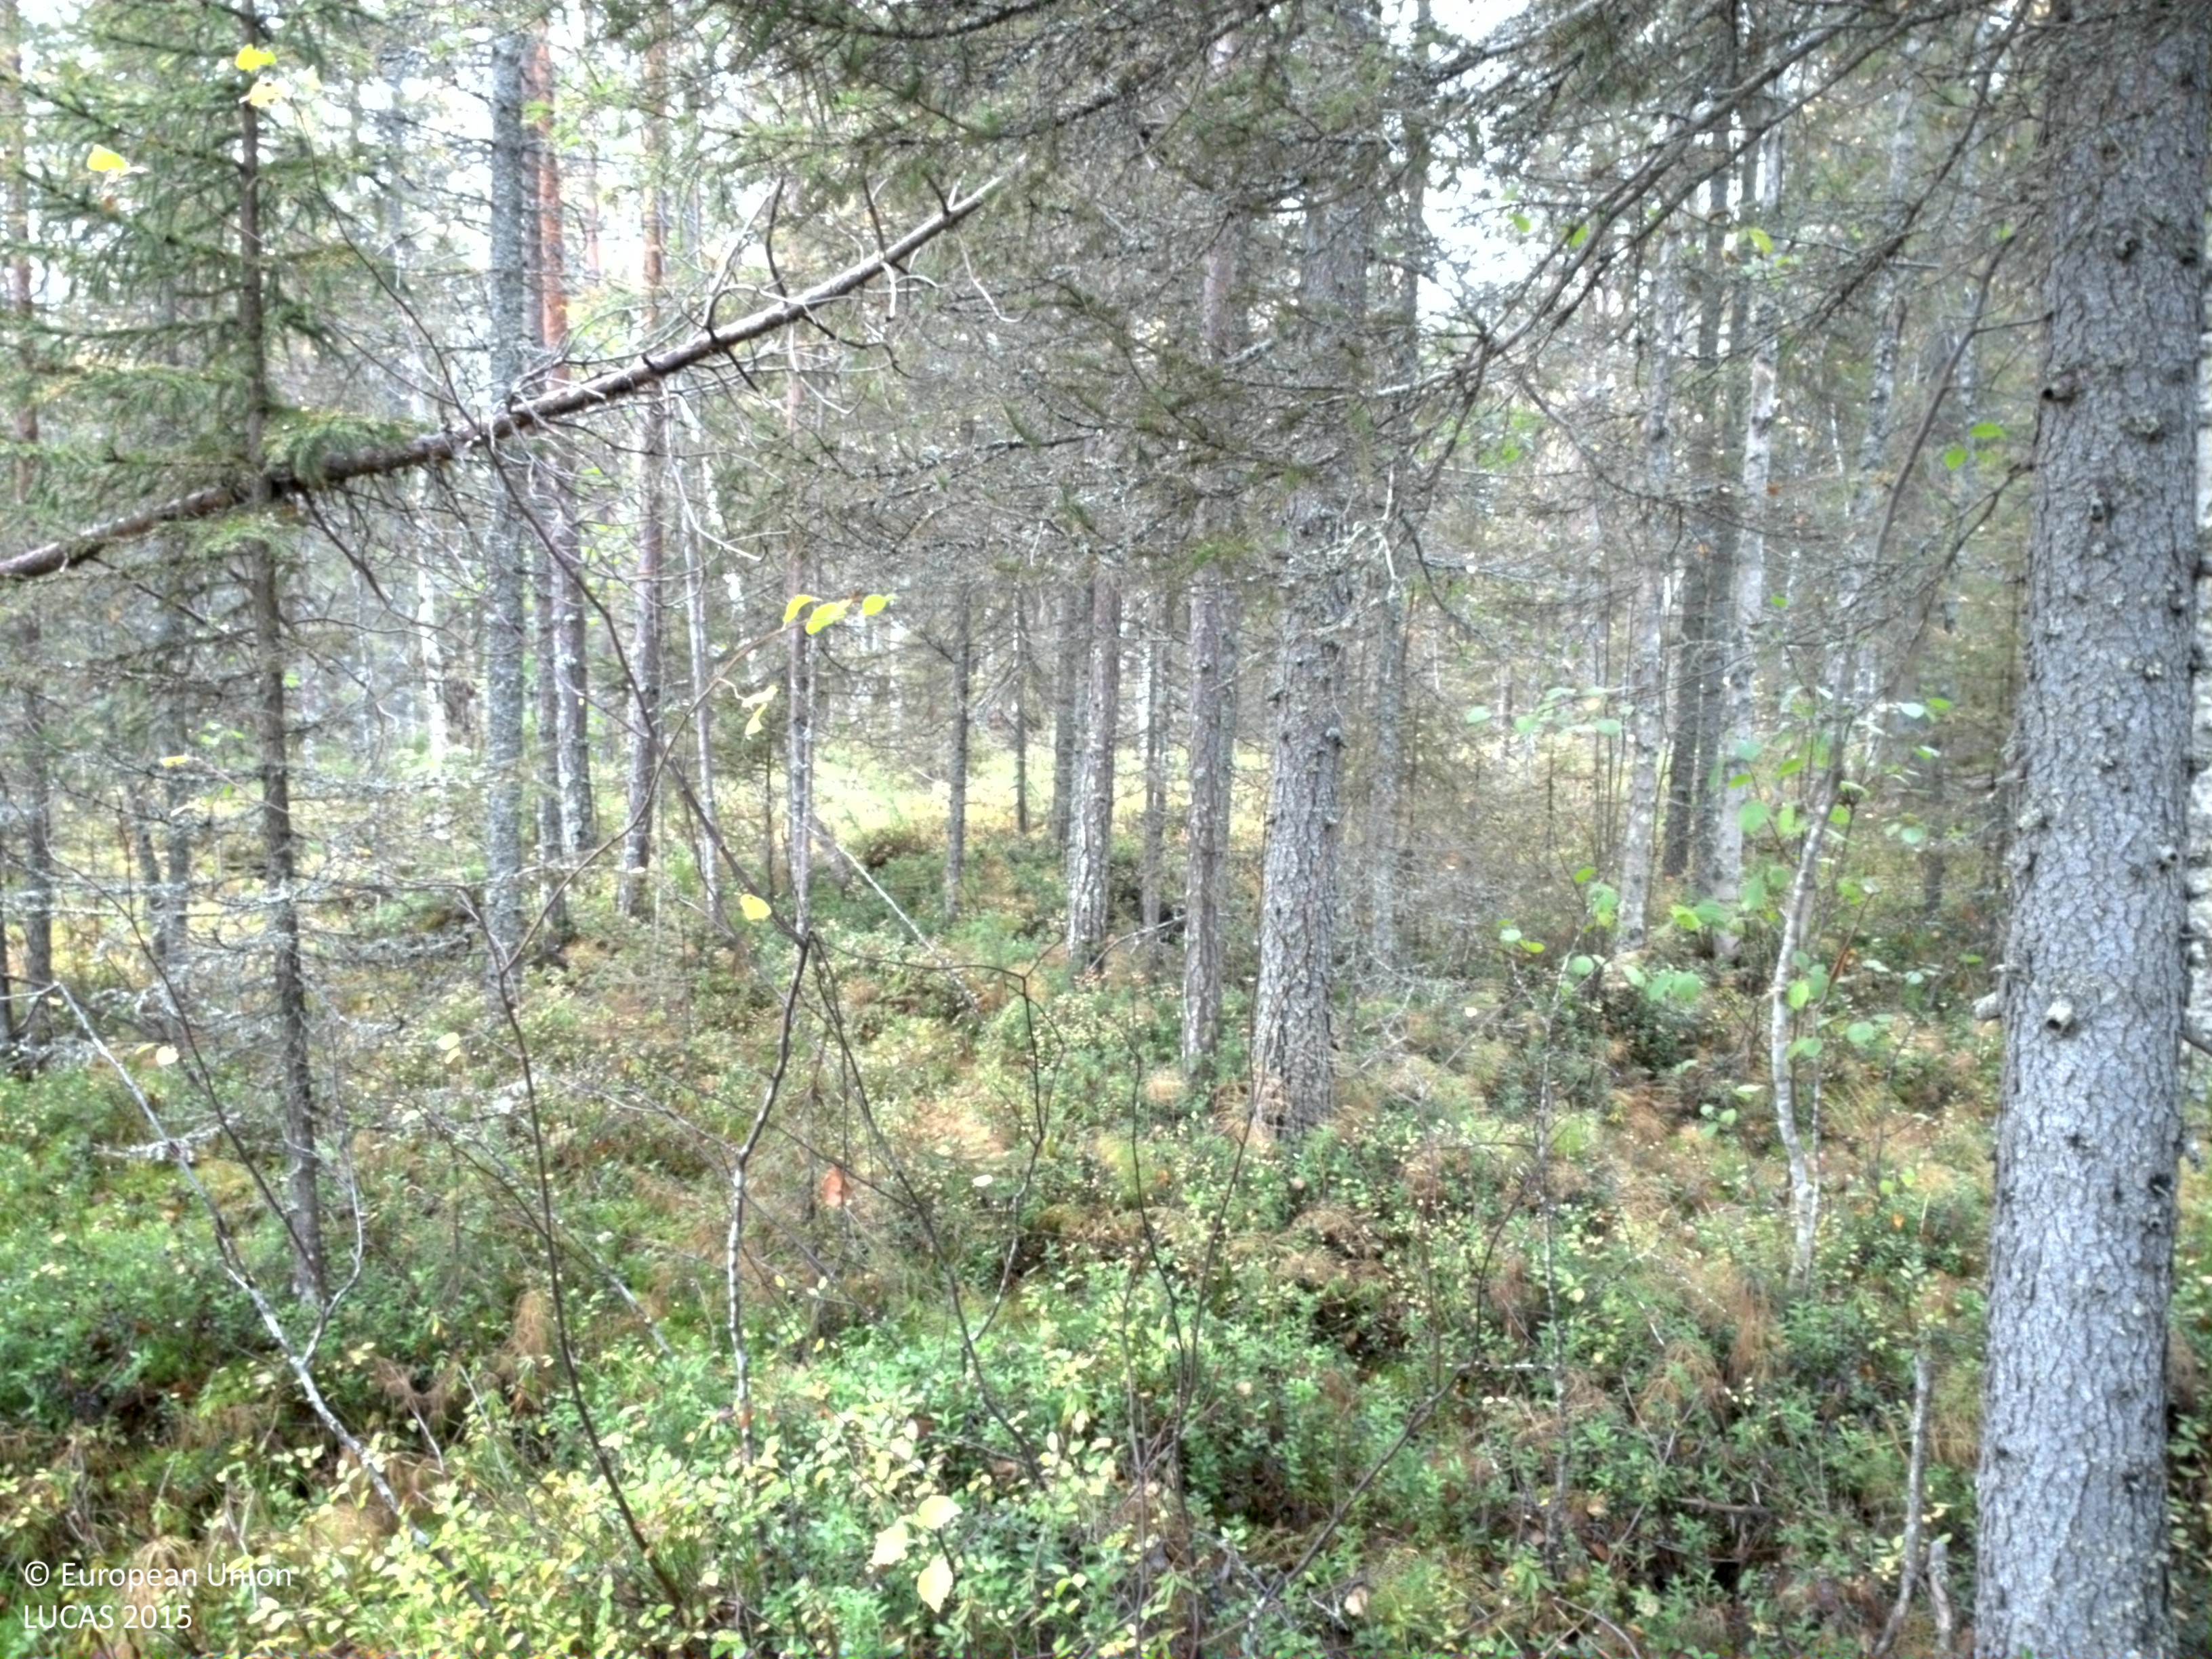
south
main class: Woodland
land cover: Pine dominated coniferous woodland
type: boreal forest
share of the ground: 25 - 50 %
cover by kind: shrubs 60 %, coniferous forest trees 35 %, broadleaved forest trees 5 %
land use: Forestry
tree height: > 5 m
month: September
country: SE
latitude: 65.7405
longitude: 21.9505
